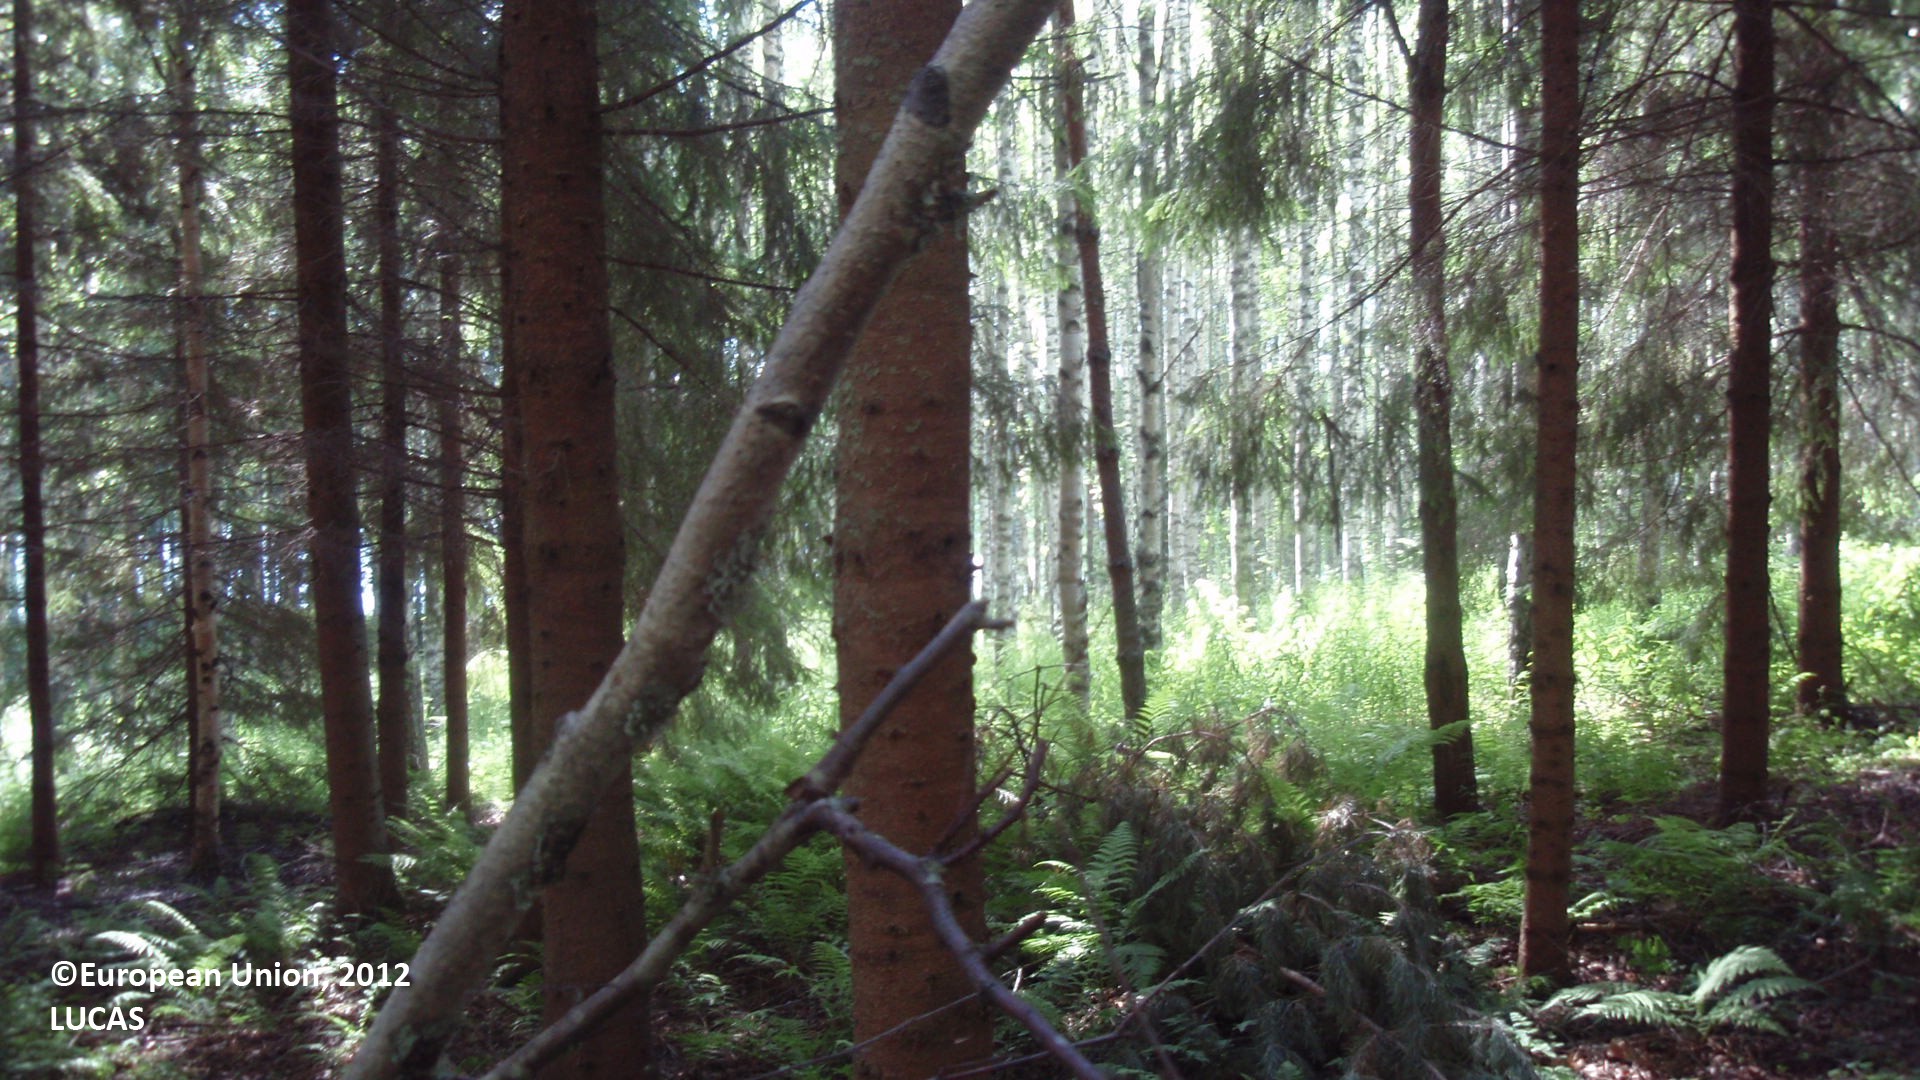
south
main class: Woodland
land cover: Spruce dominated mixed woodland
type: boreal forest
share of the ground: 25 - 50 %
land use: Forestry
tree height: > 5 m
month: July
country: FI
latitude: 61.7120
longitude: 28.1872
